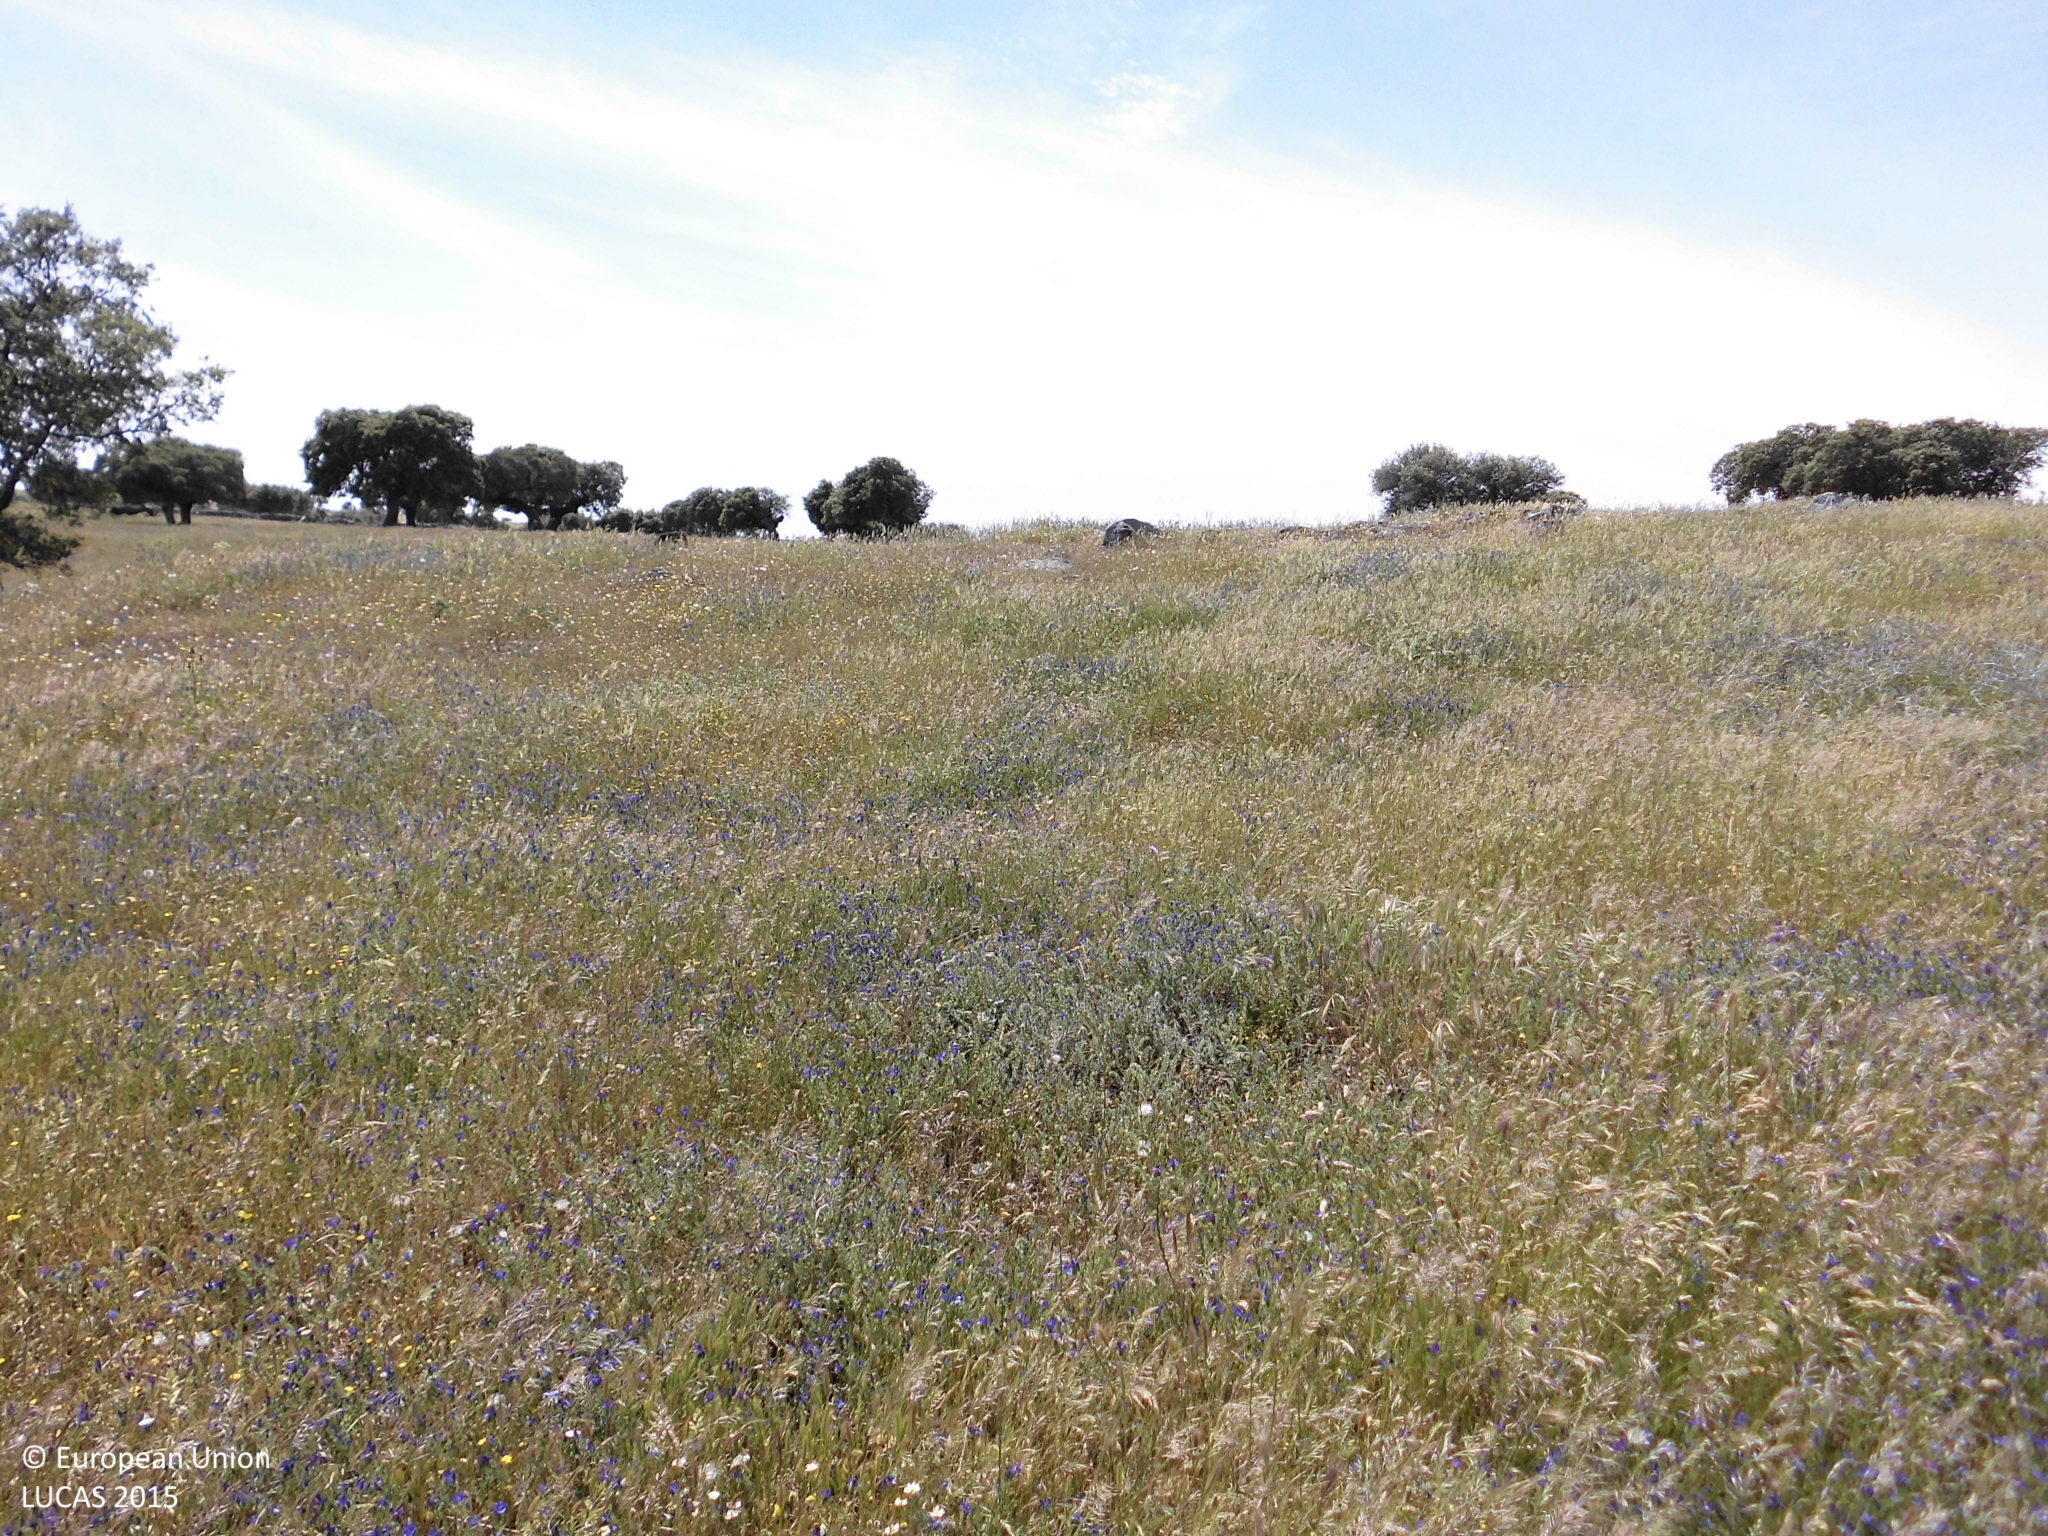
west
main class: Grassland
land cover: Grassland without tree/shrub cover
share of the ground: > 75 %
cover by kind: herbaceous plants 100 %
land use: Agriculture (excluding fallow land and kitchen gardens)
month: May
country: ES
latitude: 39.5368
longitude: -6.4172
